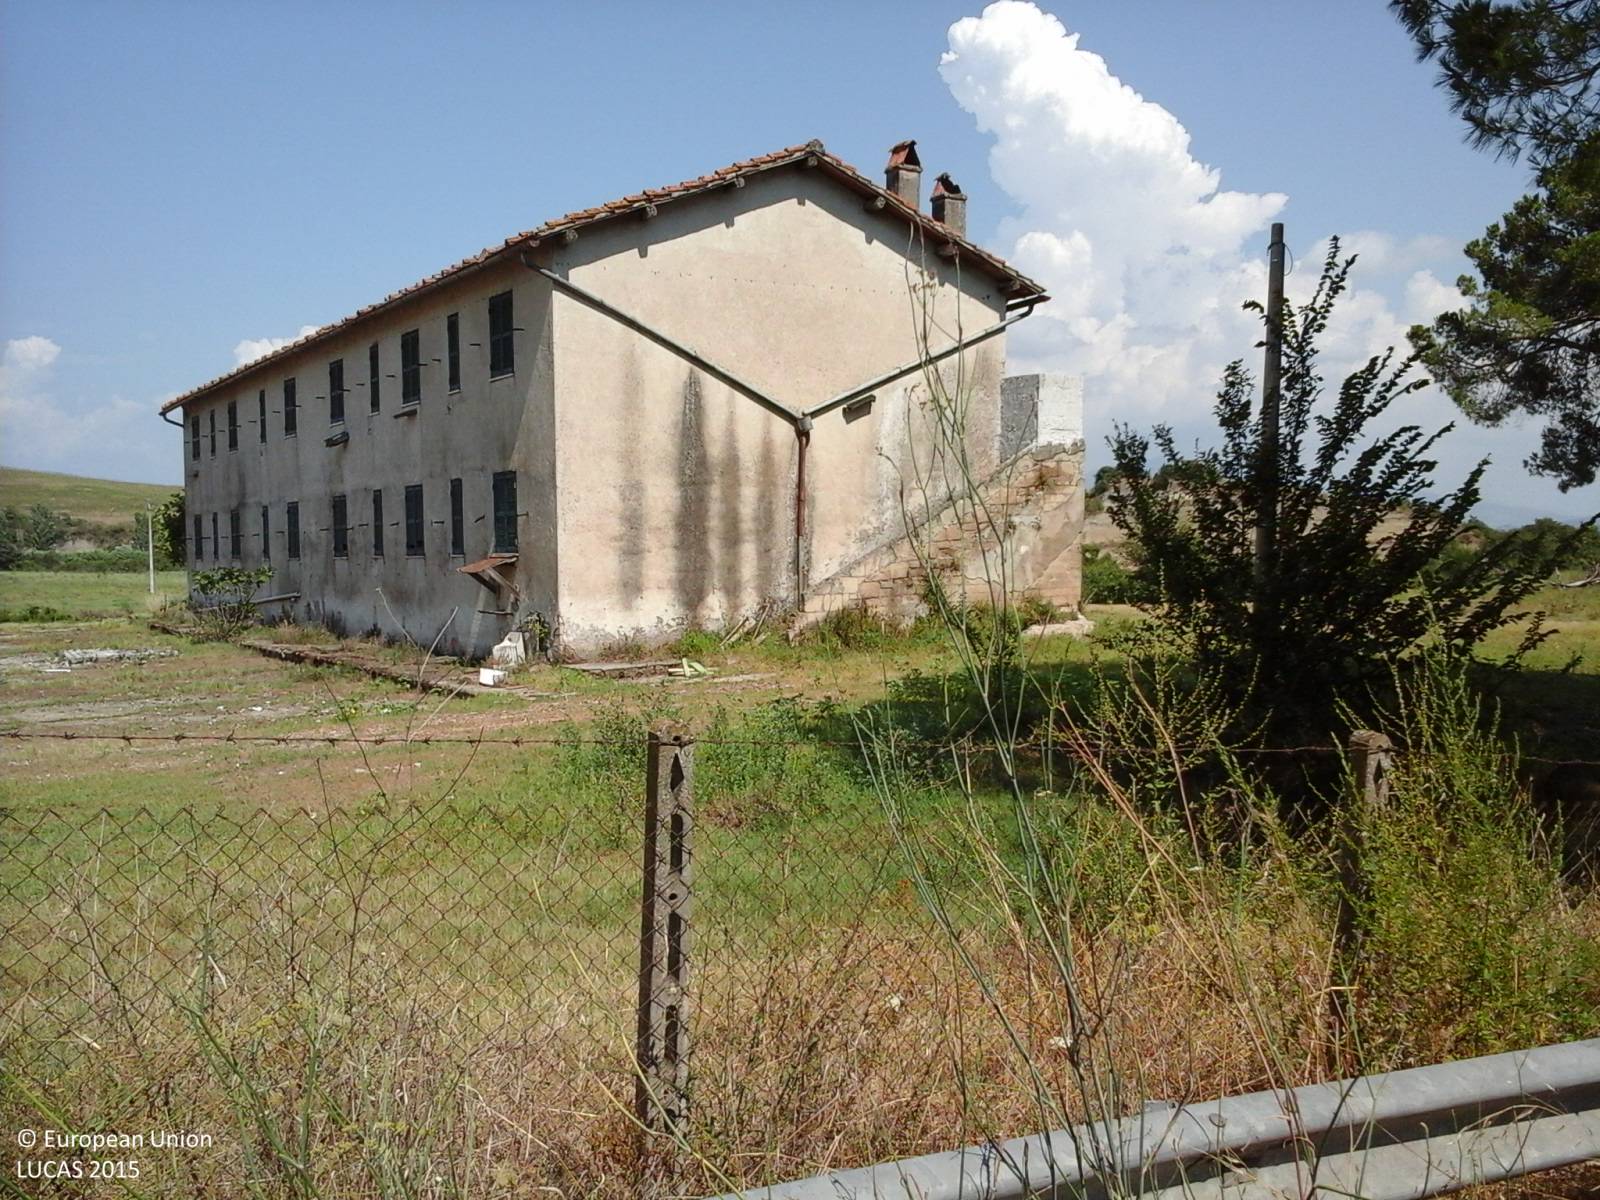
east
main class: Grassland
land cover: Grassland without tree/shrub cover
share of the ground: > 75 %
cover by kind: herbaceous plants 100 %
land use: Agriculture (excluding fallow land and kitchen gardens)
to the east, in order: Grassland without tree/shrub cover; Single bushes/trees; Grassland without tree/shrub cover; Grassland with sparse tree/shrub cover; Tracks; Grassland with sparse tree/shrub cover; Permanent crops (only in case pi)
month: July
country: IT
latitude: 42.0974
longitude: 12.5663
